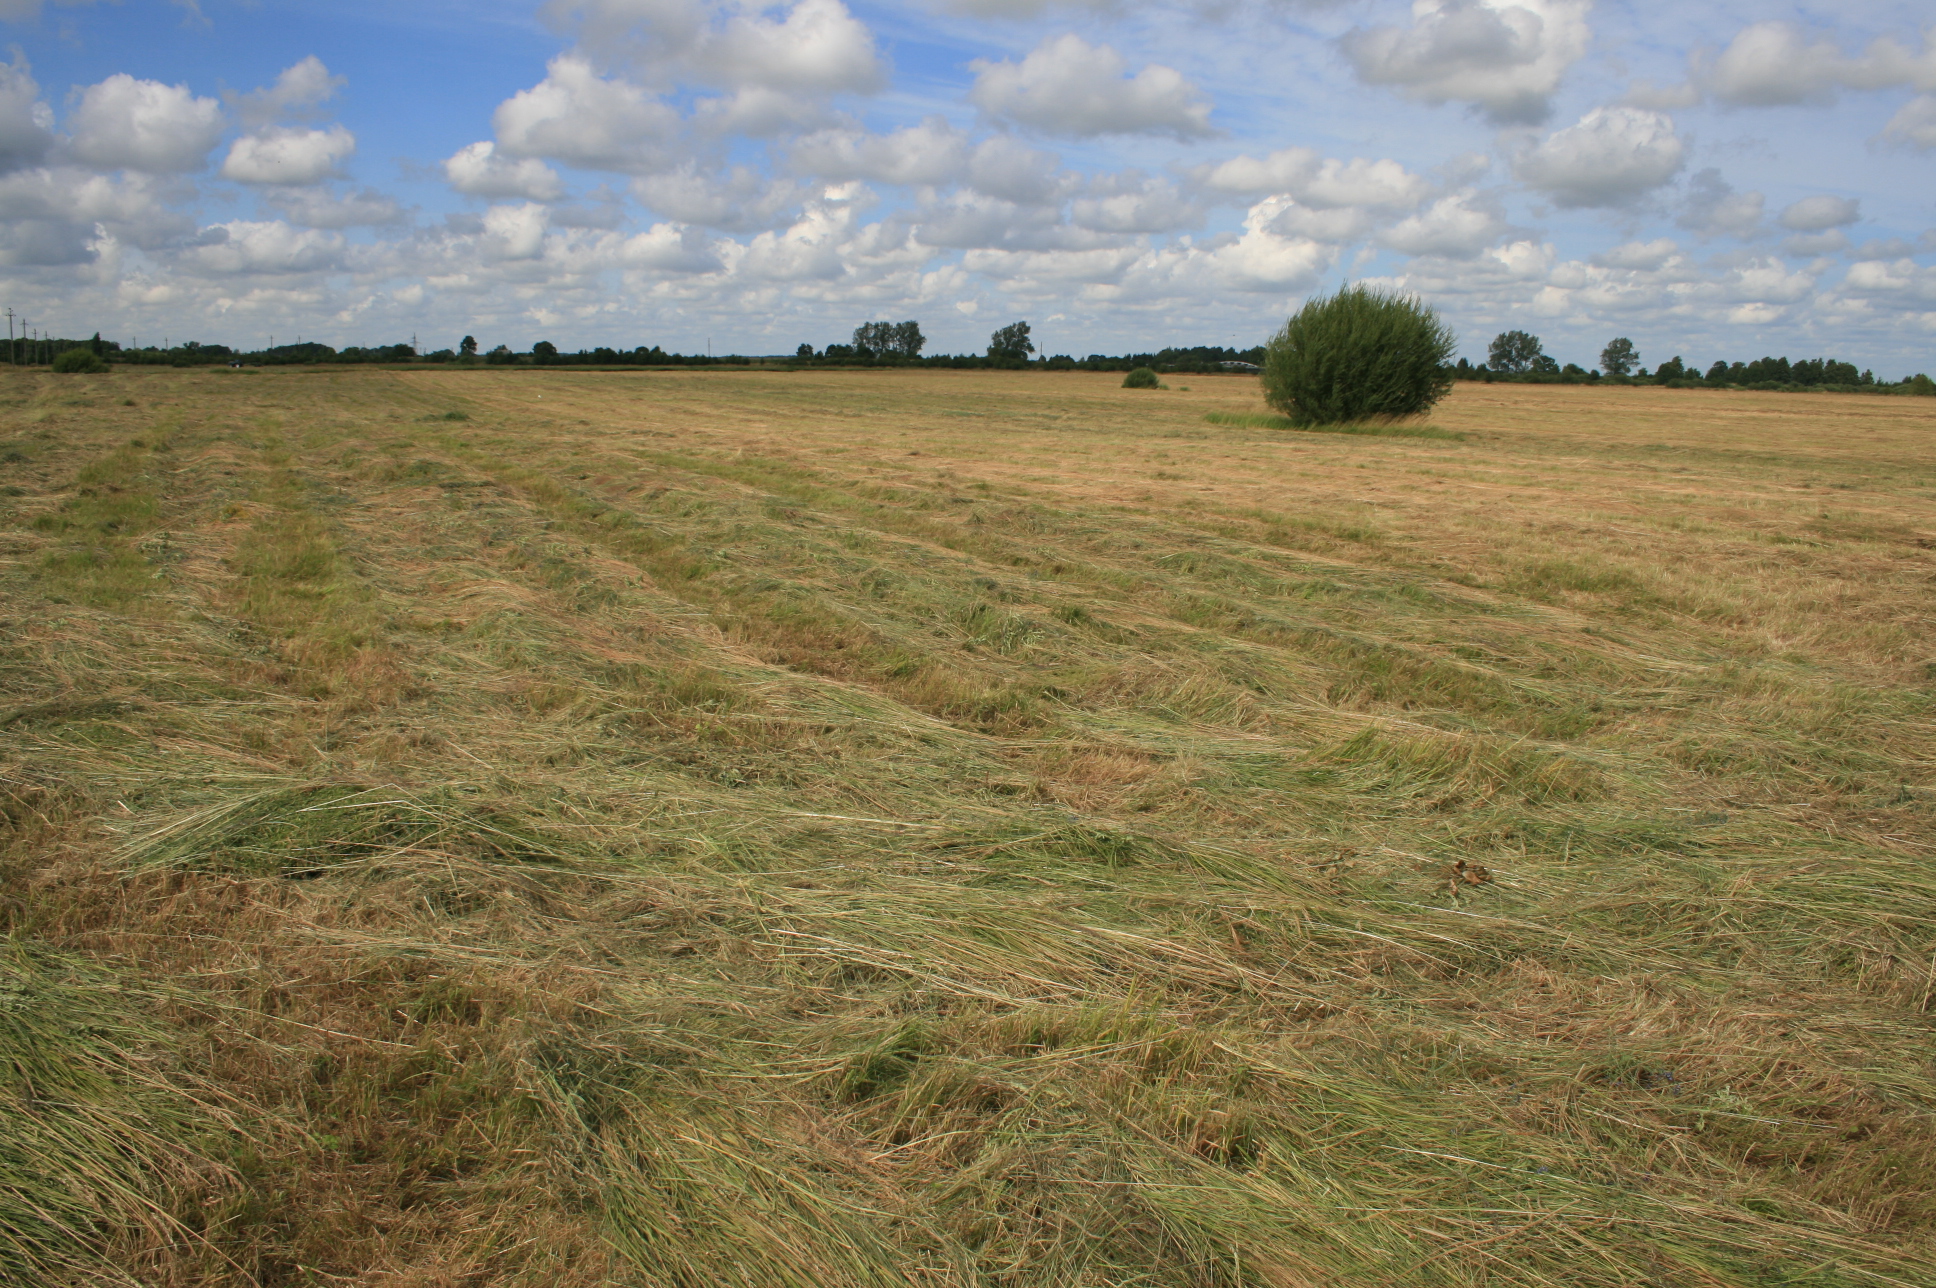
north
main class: Grassland
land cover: Grassland without tree/shrub cover
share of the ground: > 75 %
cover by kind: herbaceous plants 100 %
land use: Agriculture (excluding fallow land and kitchen gardens)
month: July
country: LT
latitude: 55.5377
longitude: 21.3416
